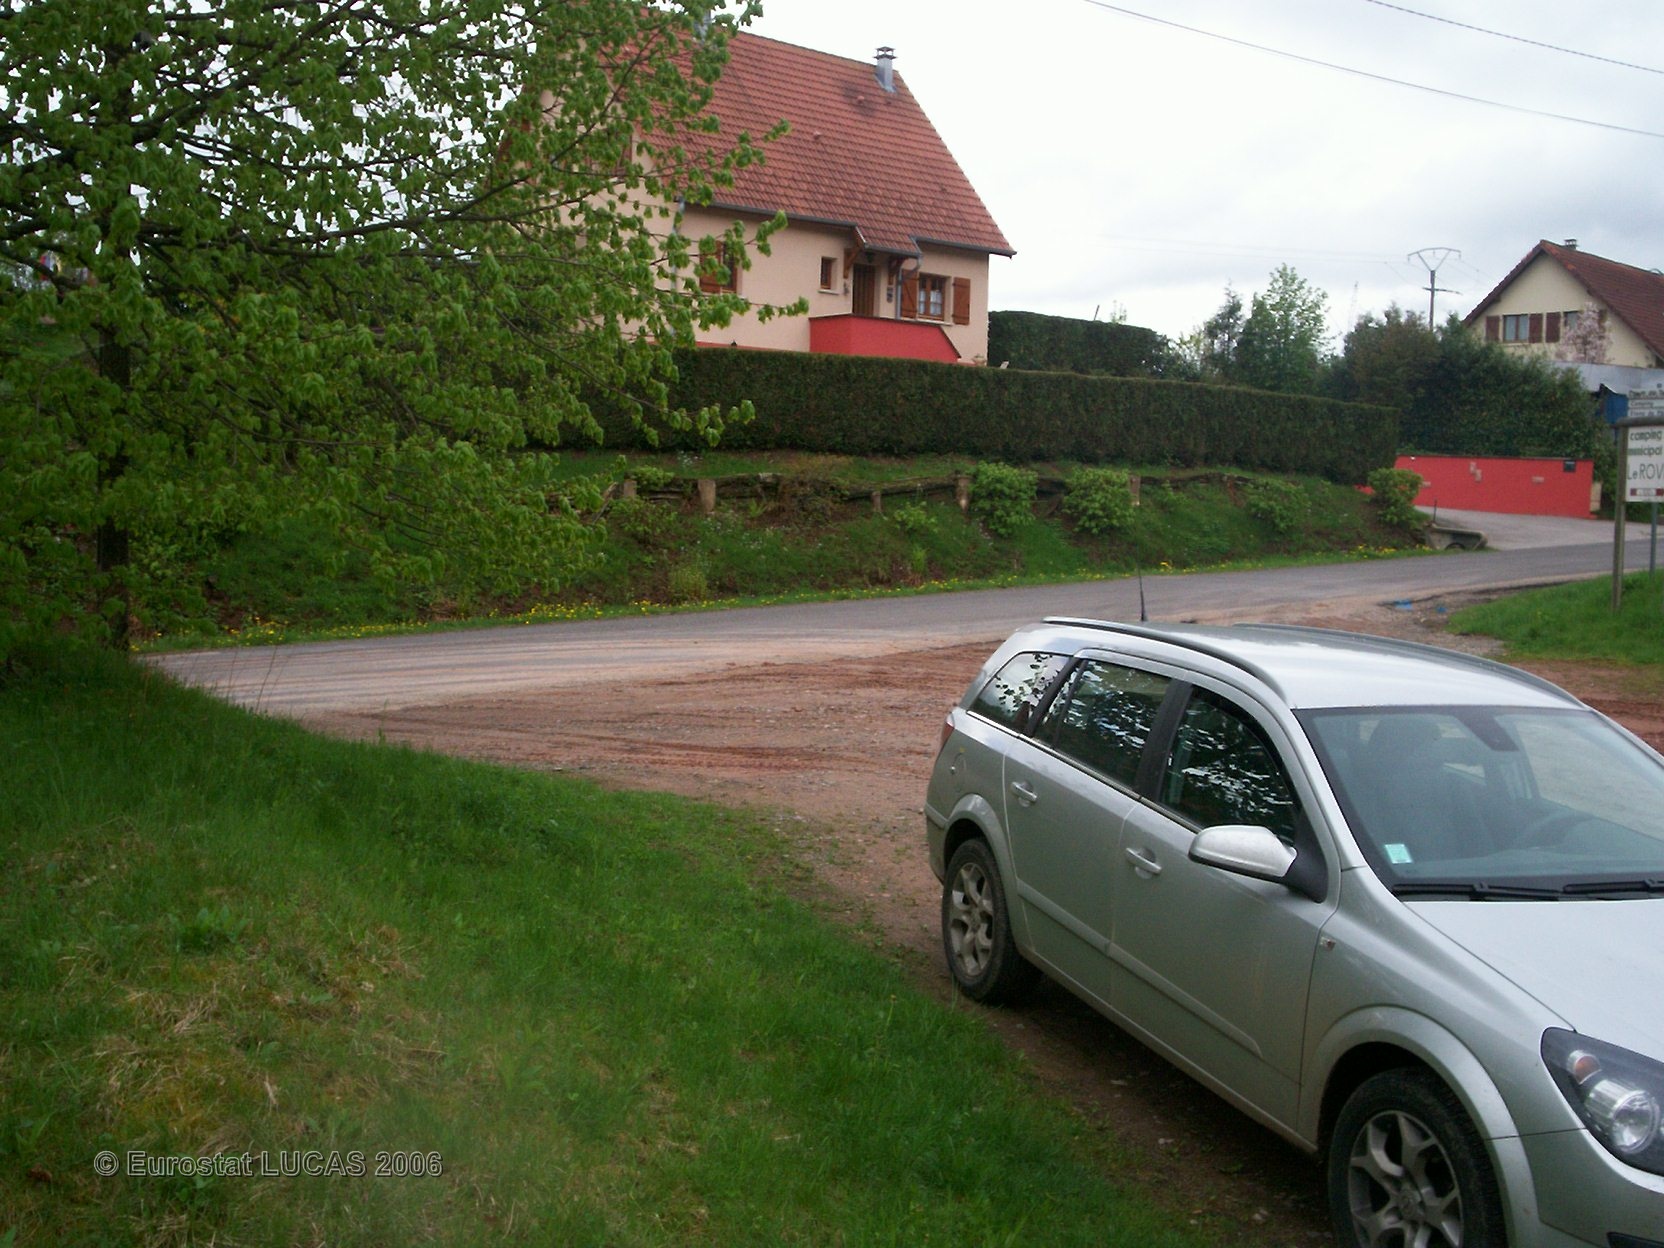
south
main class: Grassland
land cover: Grassland with sparse tree/shrub cover
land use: Amenities, museums, leisure
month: May
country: FR
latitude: 48.3475
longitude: 7.0998
